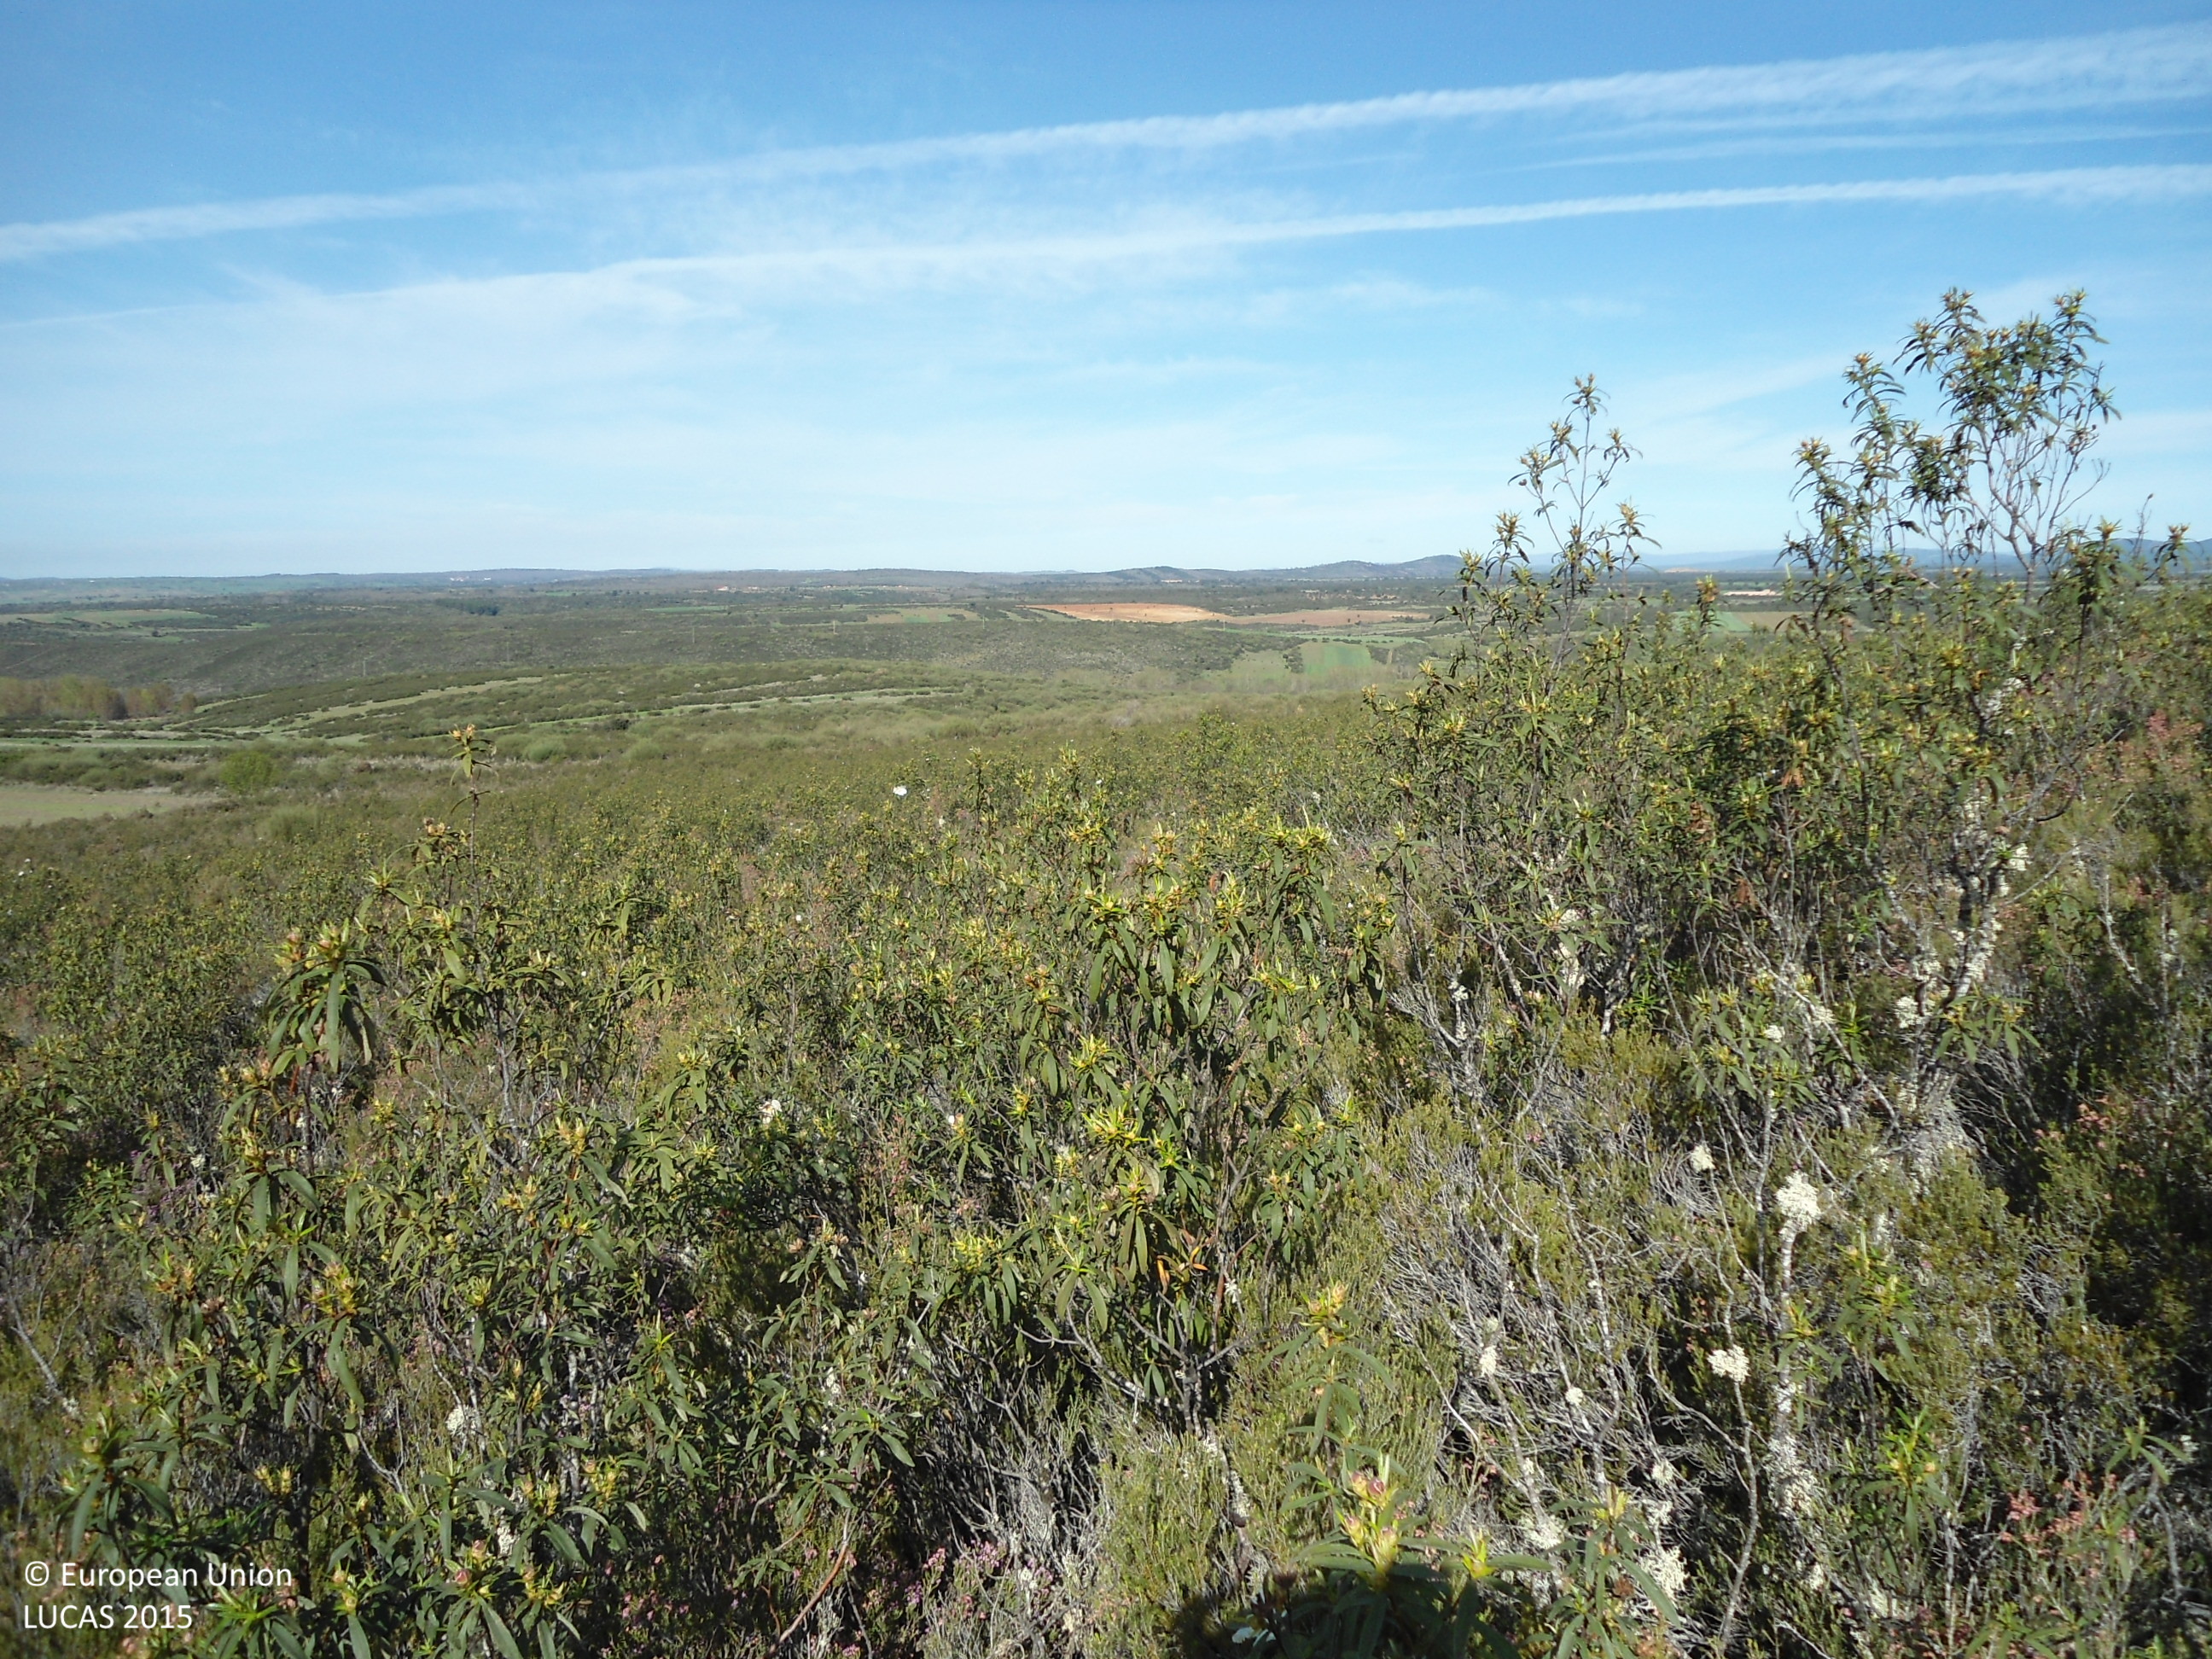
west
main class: Shrubland
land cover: Shrubland without tree cover
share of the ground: > 75 %
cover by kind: shrubs 100 %
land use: Semi-natural and natural areas not in use
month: April
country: ES
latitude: 41.7870
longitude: -6.1630
